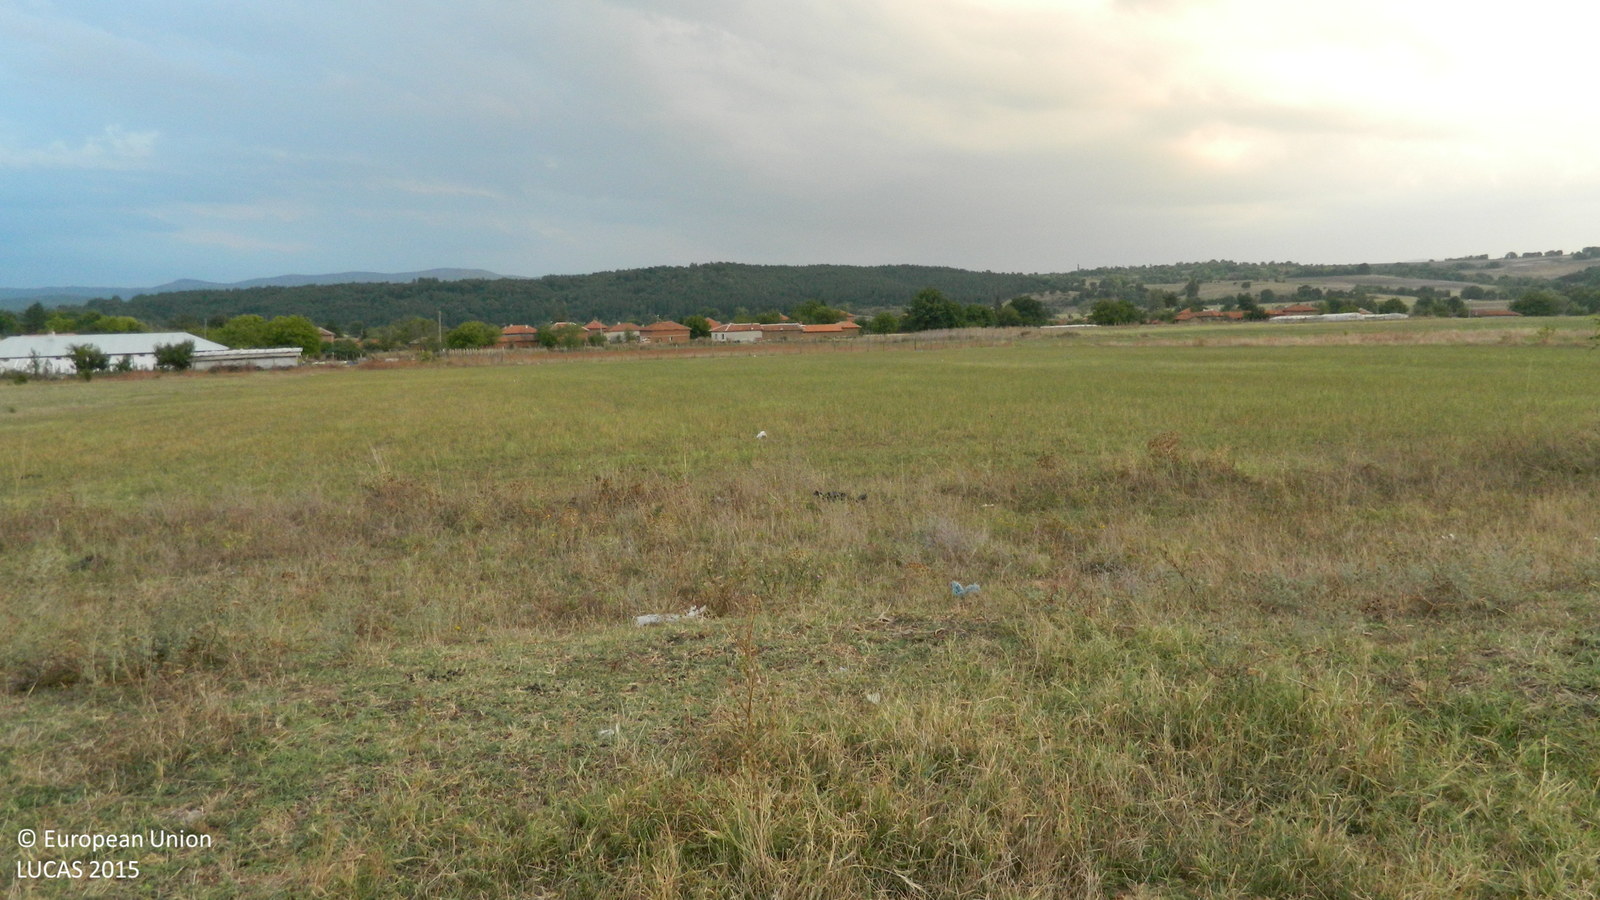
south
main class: Grassland
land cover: Grassland without tree/shrub cover
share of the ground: > 75 %
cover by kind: herbaceous plants 100 %
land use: Agriculture (excluding fallow land and kitchen gardens)
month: September
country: BG
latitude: 41.8127
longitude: 25.7762
